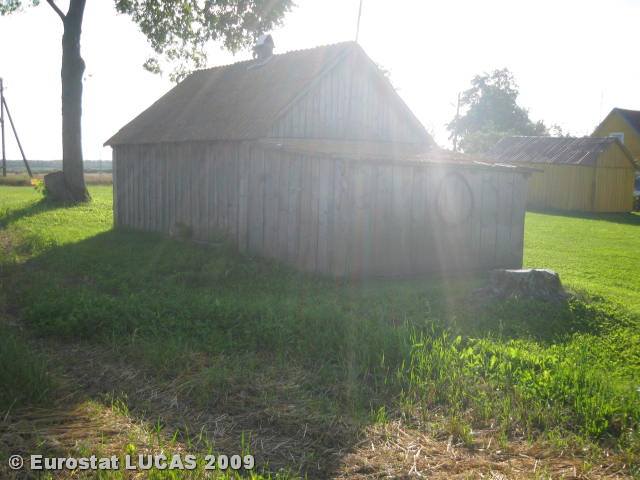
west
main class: Grassland
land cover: Grassland without tree/shrub cover
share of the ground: 25 - 50 %
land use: Fallow land
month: August
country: LT
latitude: 55.3079
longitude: 23.6468
